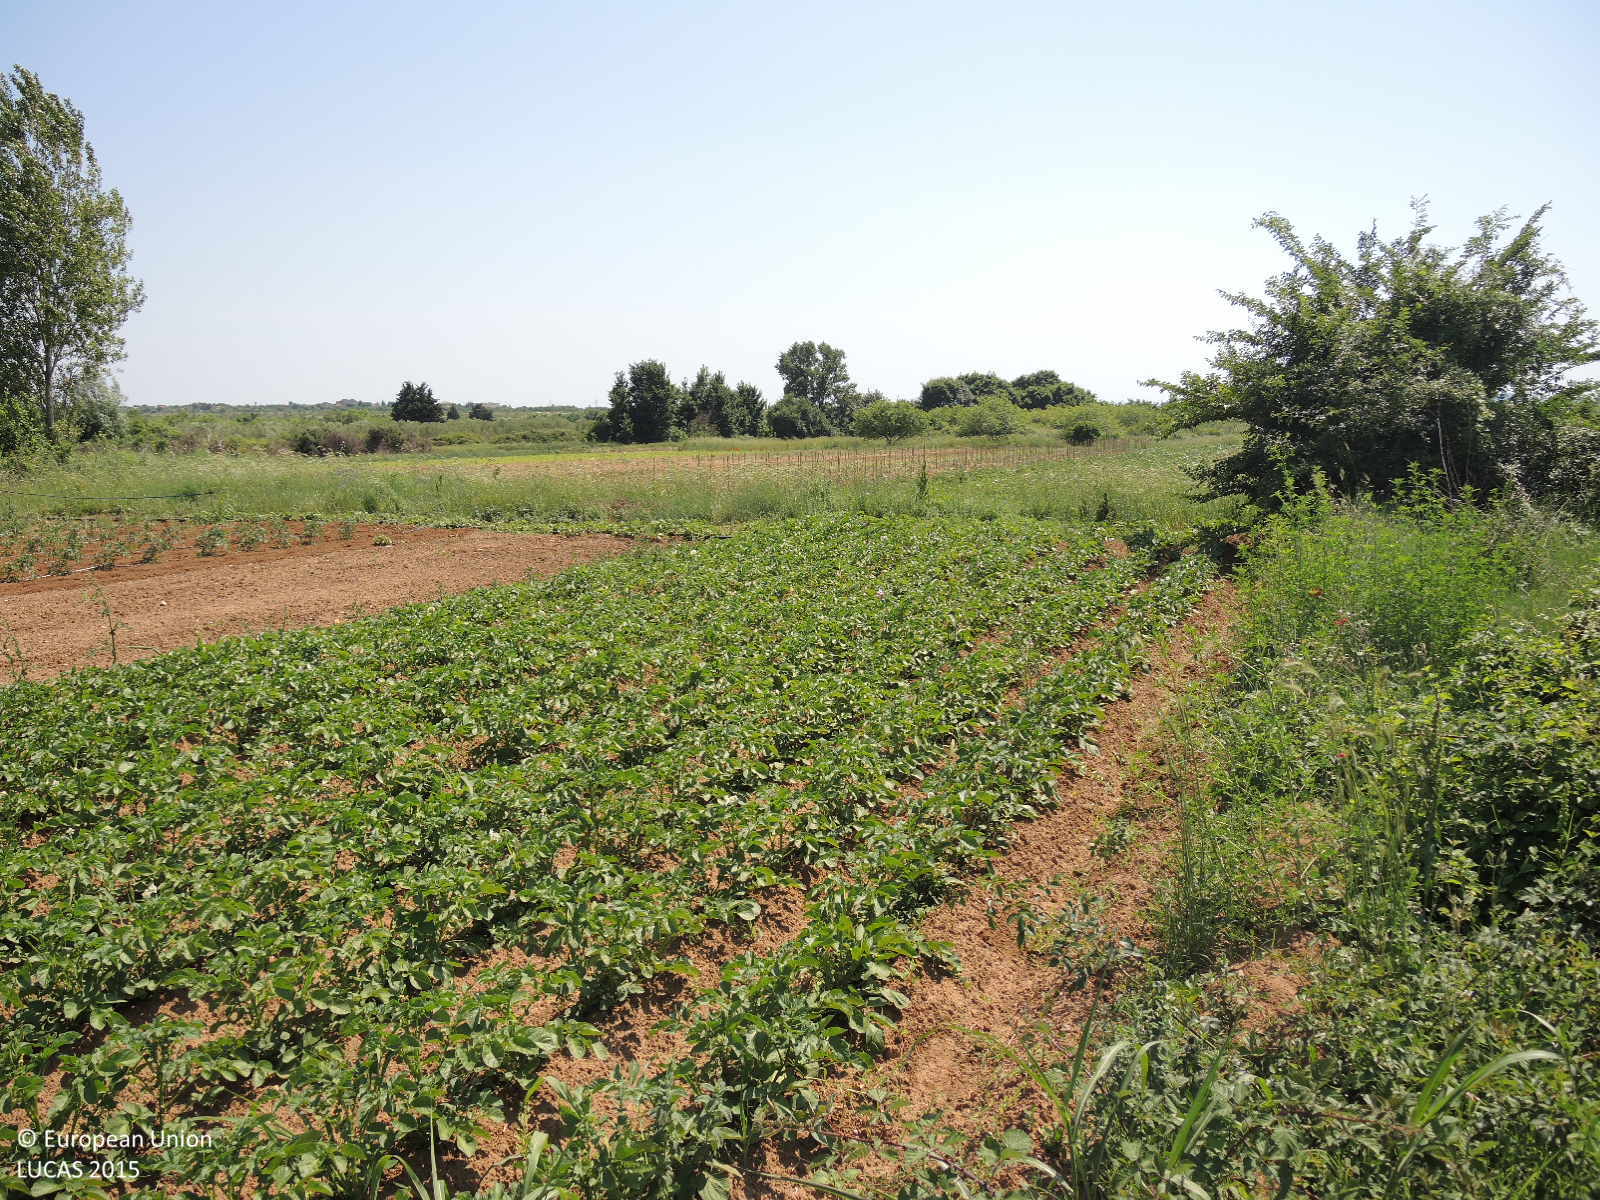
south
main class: Shrubland
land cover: Shrubland without tree cover
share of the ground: 50 - 75 %
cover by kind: shrubs 70 %, herbaceous plants 20 %, unconsolidated bare surface 10 %
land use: Semi-natural and natural areas not in use
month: May
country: HR
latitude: 44.1155
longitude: 15.4774
